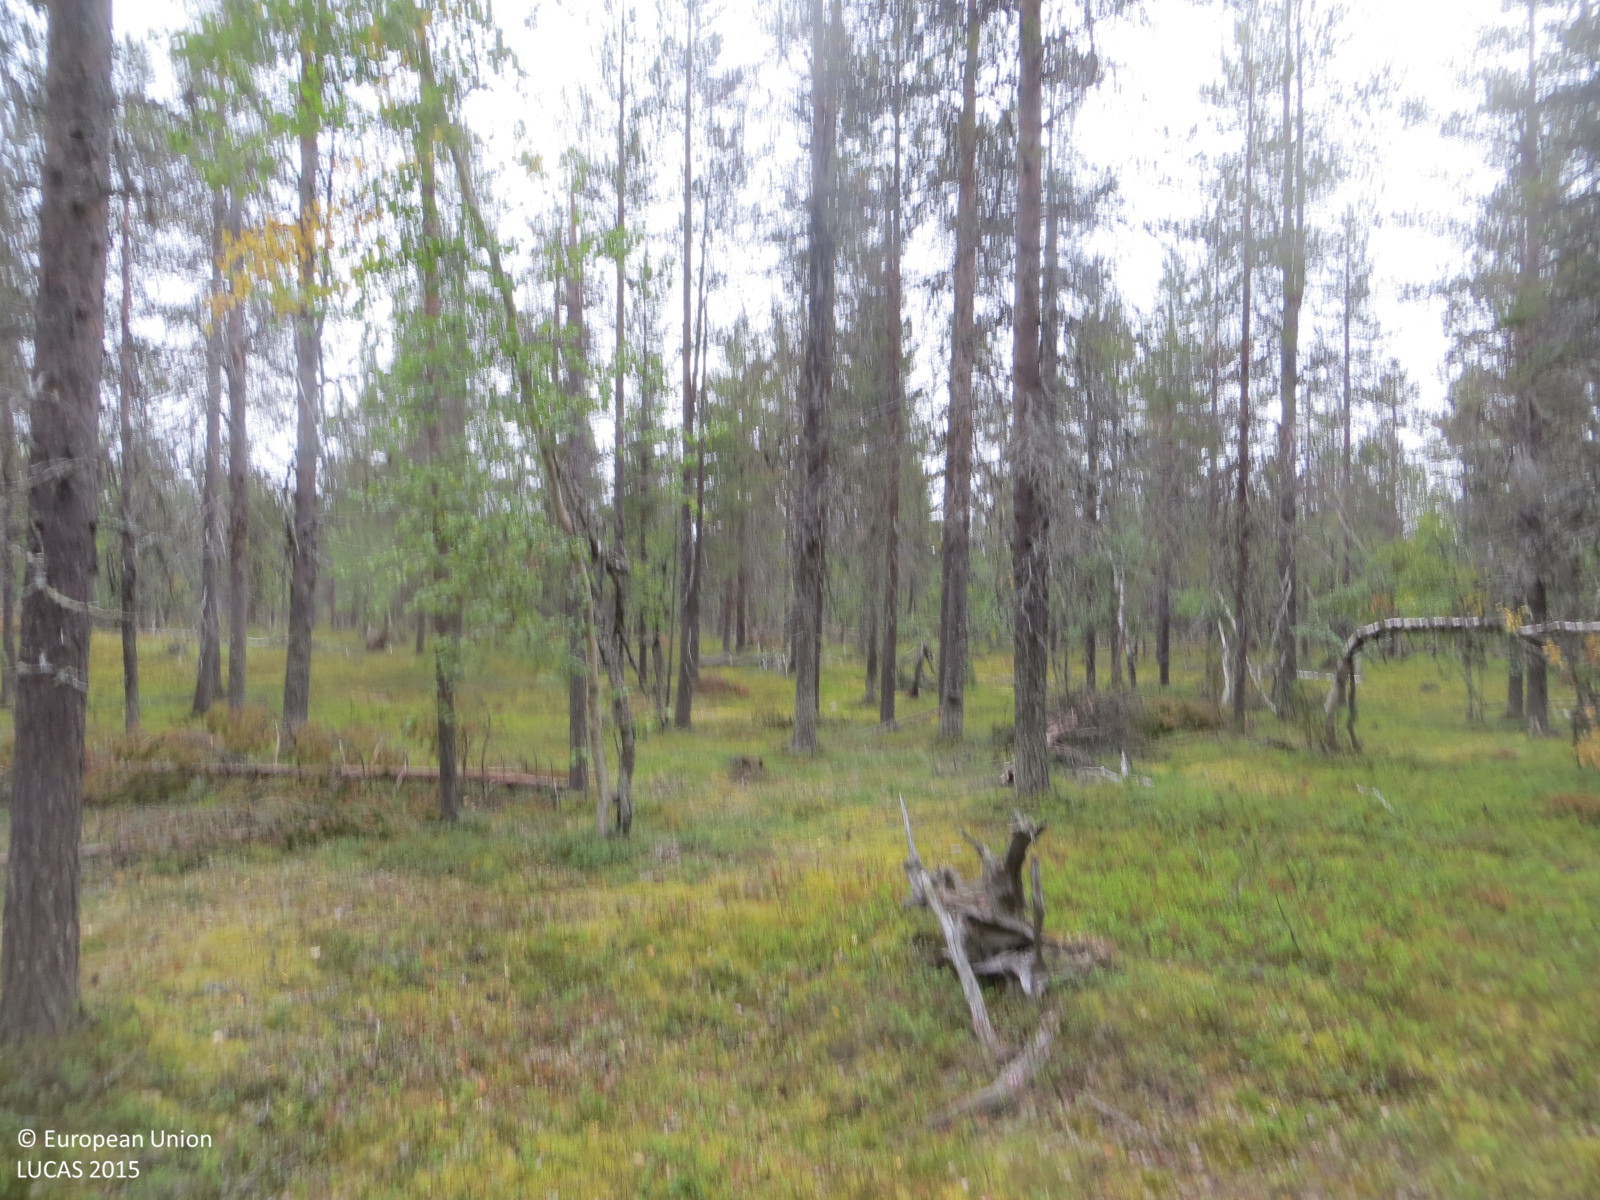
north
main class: Woodland
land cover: Pine dominated coniferous woodland
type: boreal forest
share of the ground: 50 - 75 %
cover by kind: coniferous forest trees 50 %, shrubs 50 %
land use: Forestry
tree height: > 5 m
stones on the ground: 25 - 50 %
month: August
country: FI
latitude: 68.1420
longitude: 25.6135
